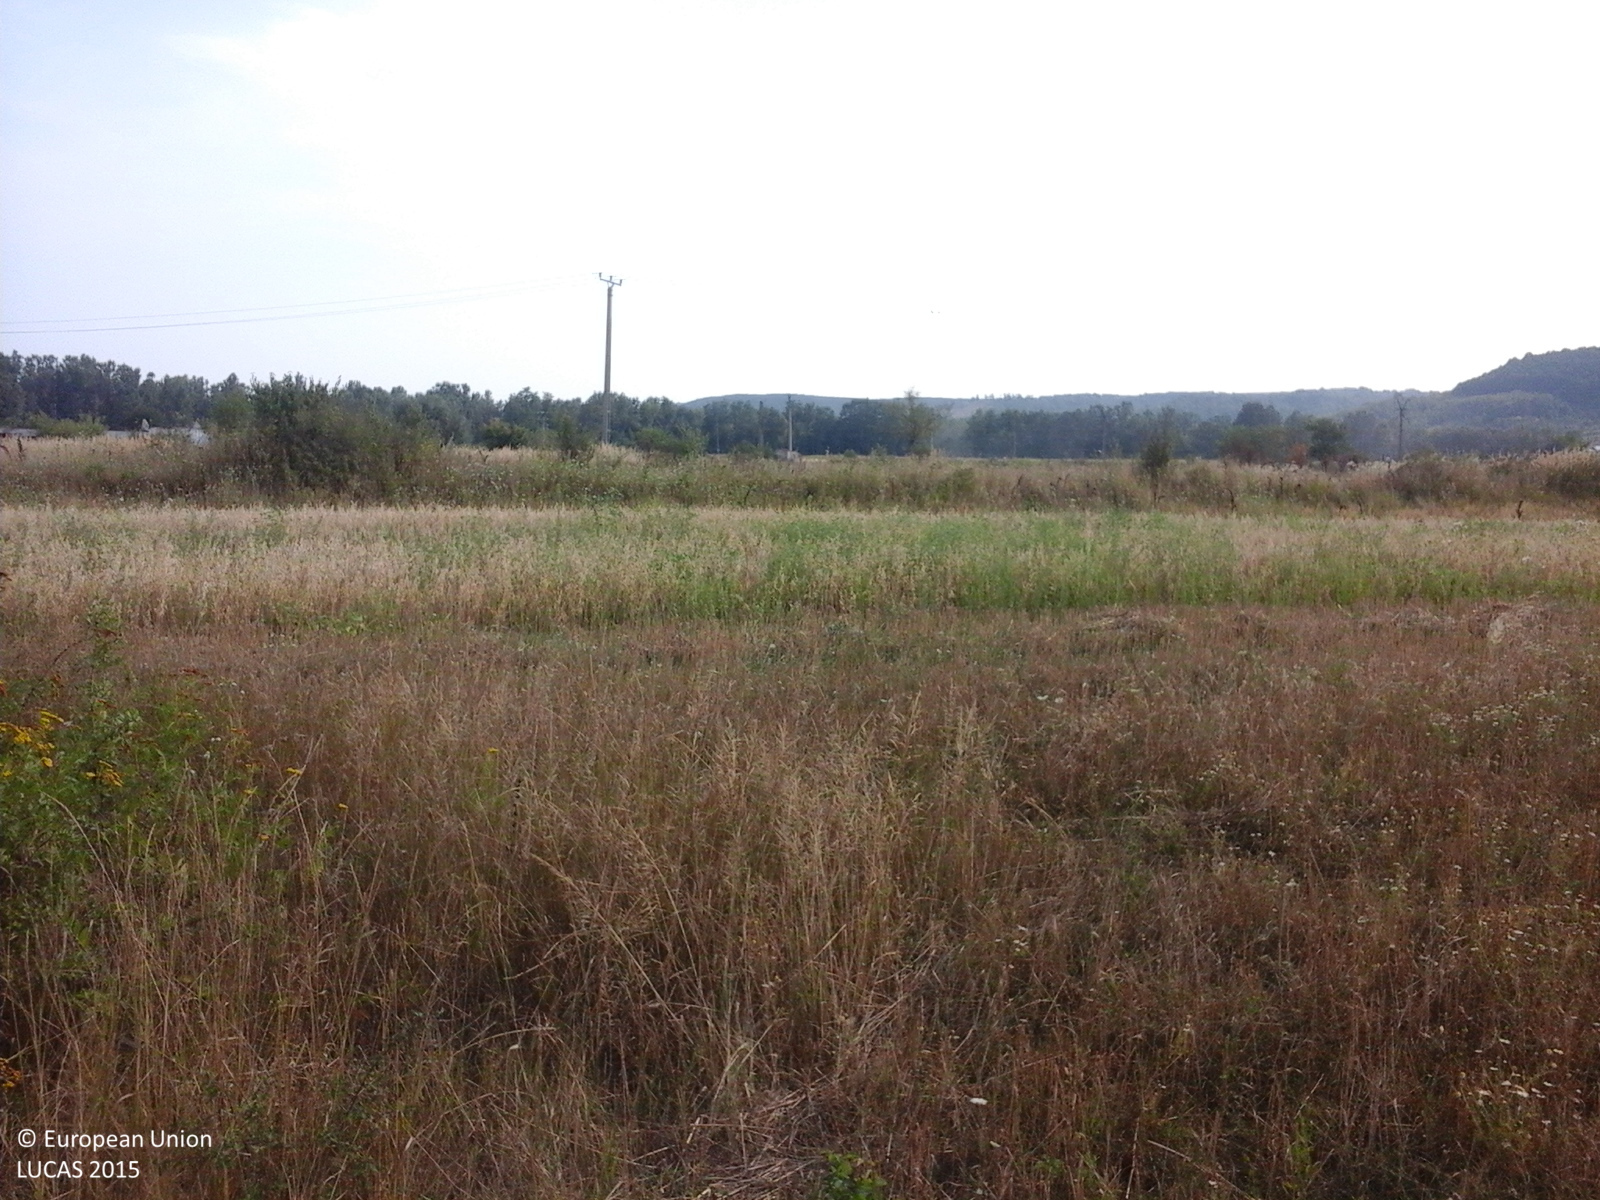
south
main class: Cropland
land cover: Common wheat
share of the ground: > 75 %
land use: Agriculture (excluding fallow land and kitchen gardens)
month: August
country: RO
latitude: 44.7252
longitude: 23.6299
